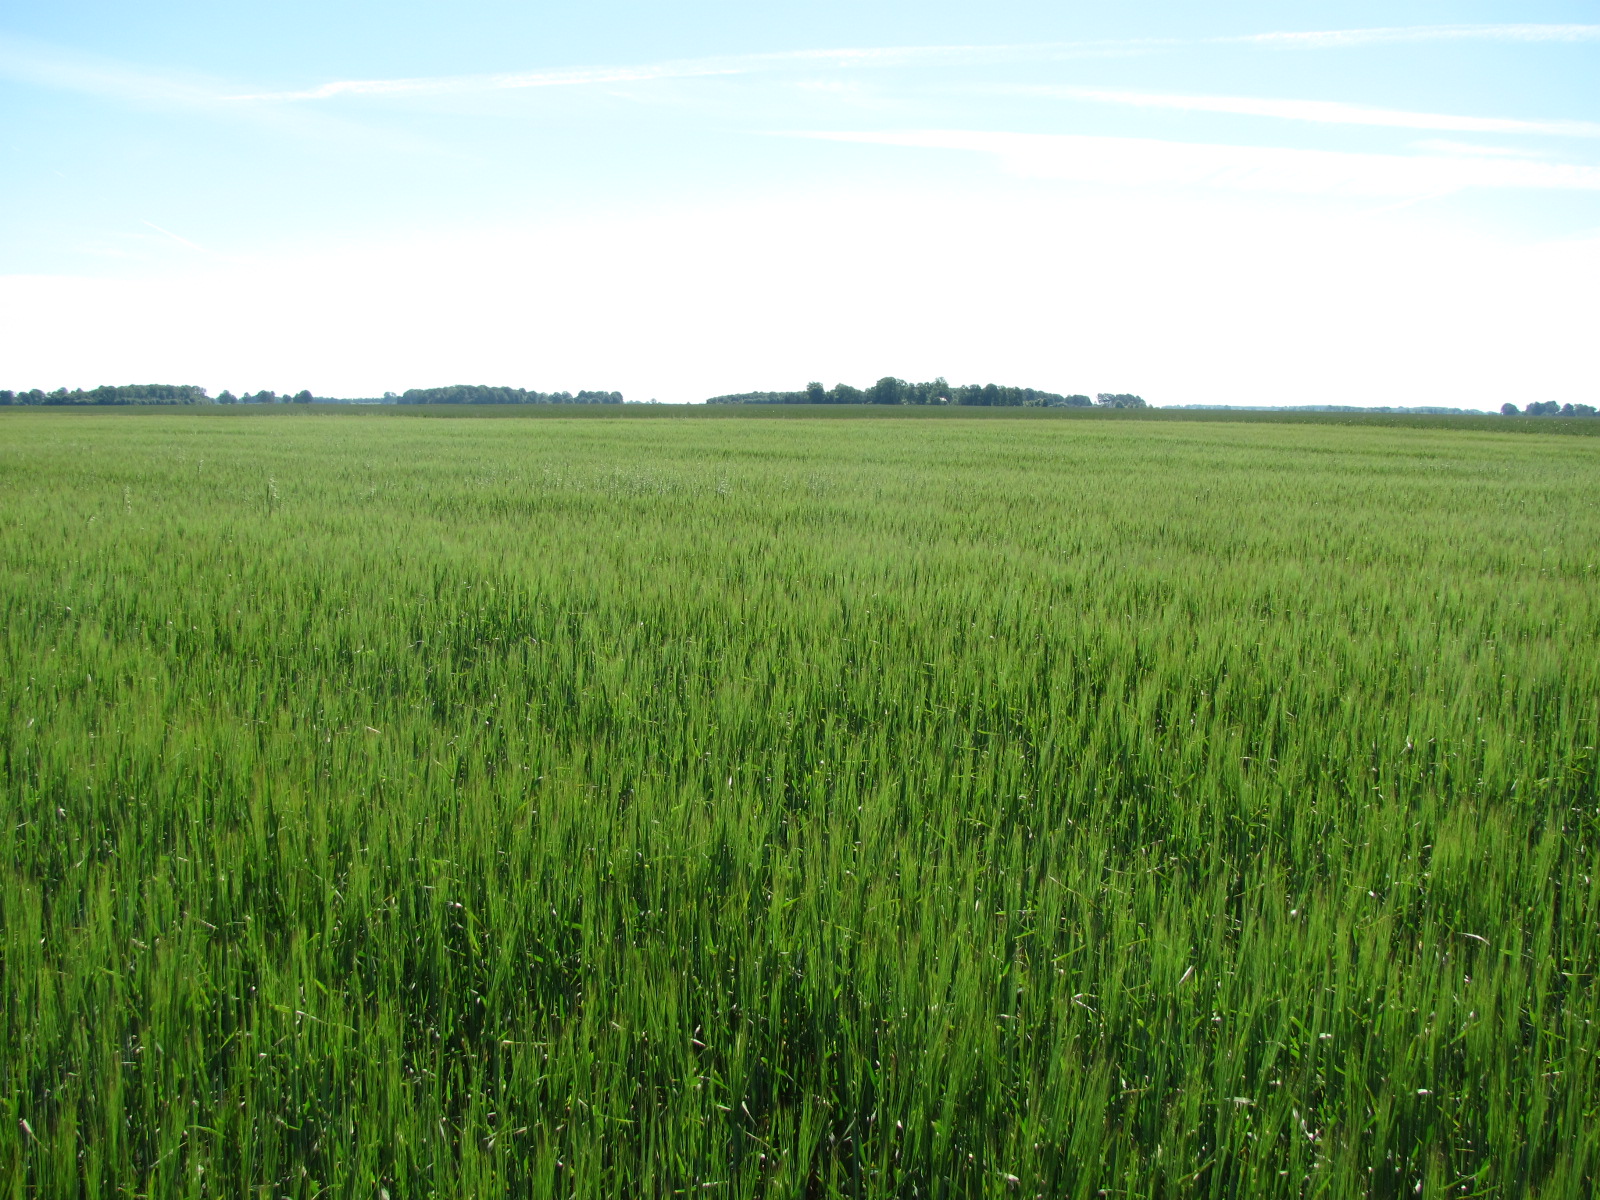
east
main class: Cropland
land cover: Barley
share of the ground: > 75 %
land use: Agriculture (excluding fallow land and kitchen gardens)
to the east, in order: Barley; Common wheat; Grass margins; Barley
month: July
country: LV
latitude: 56.4895
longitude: 23.8710
